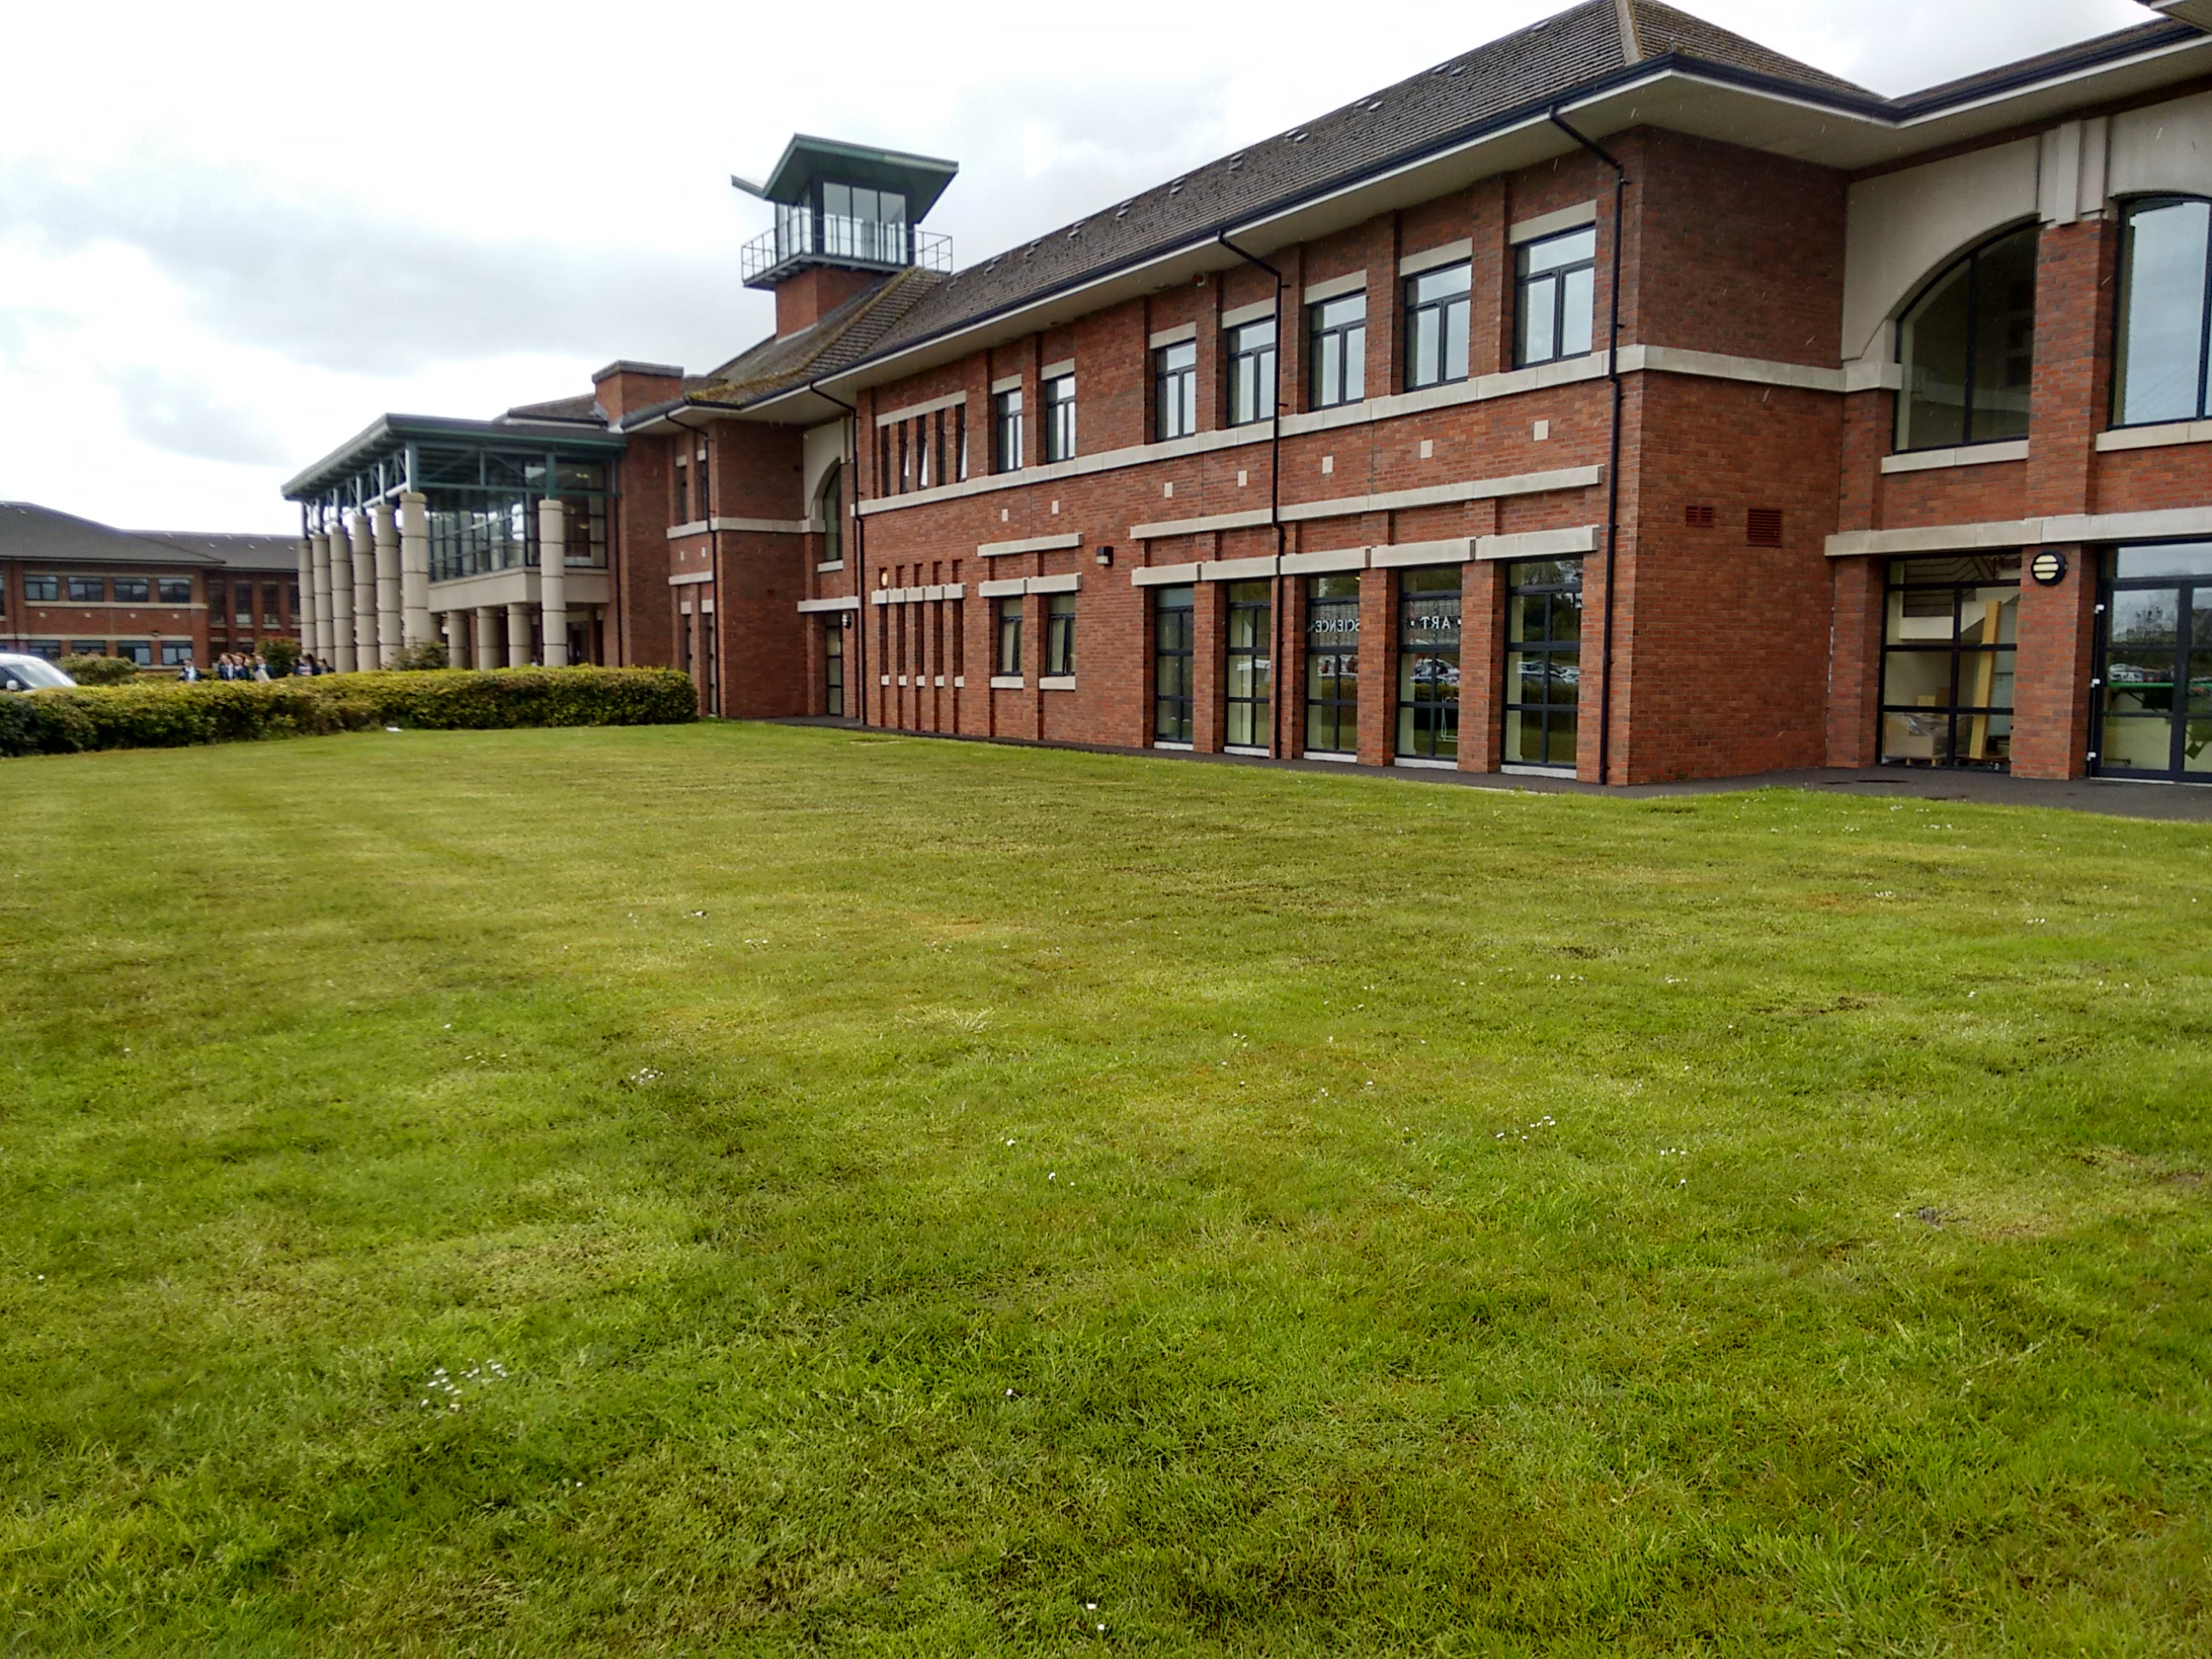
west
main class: Grassland
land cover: Grassland without tree/shrub cover
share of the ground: > 75 %
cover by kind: herbaceous plants 100 %
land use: Community services
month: May
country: GB
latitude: 55.0382
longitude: -7.2811
